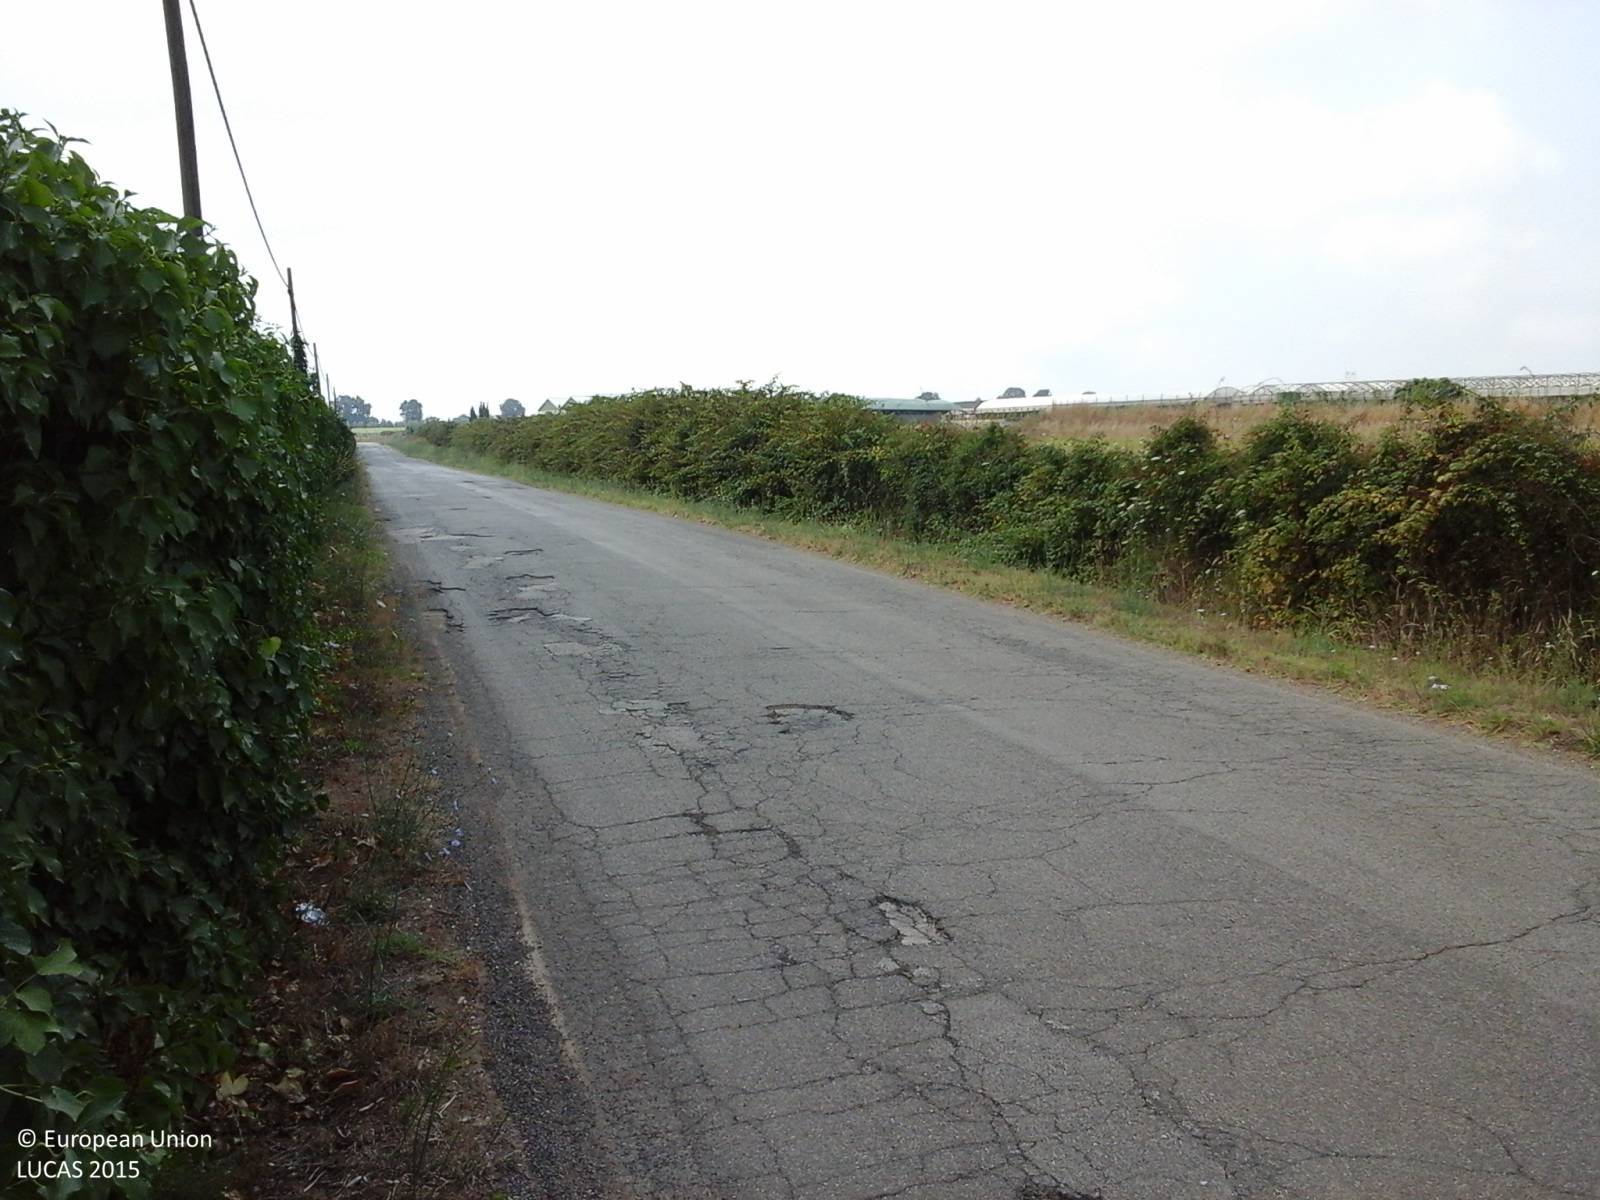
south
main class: Cropland
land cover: Vineyards
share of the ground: > 75 %
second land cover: Spontaneously vegetated surfaces
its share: > 75 %
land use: Agriculture (excluding fallow land and kitchen gardens)
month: July
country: IT
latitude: 41.5143
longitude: 12.7330
